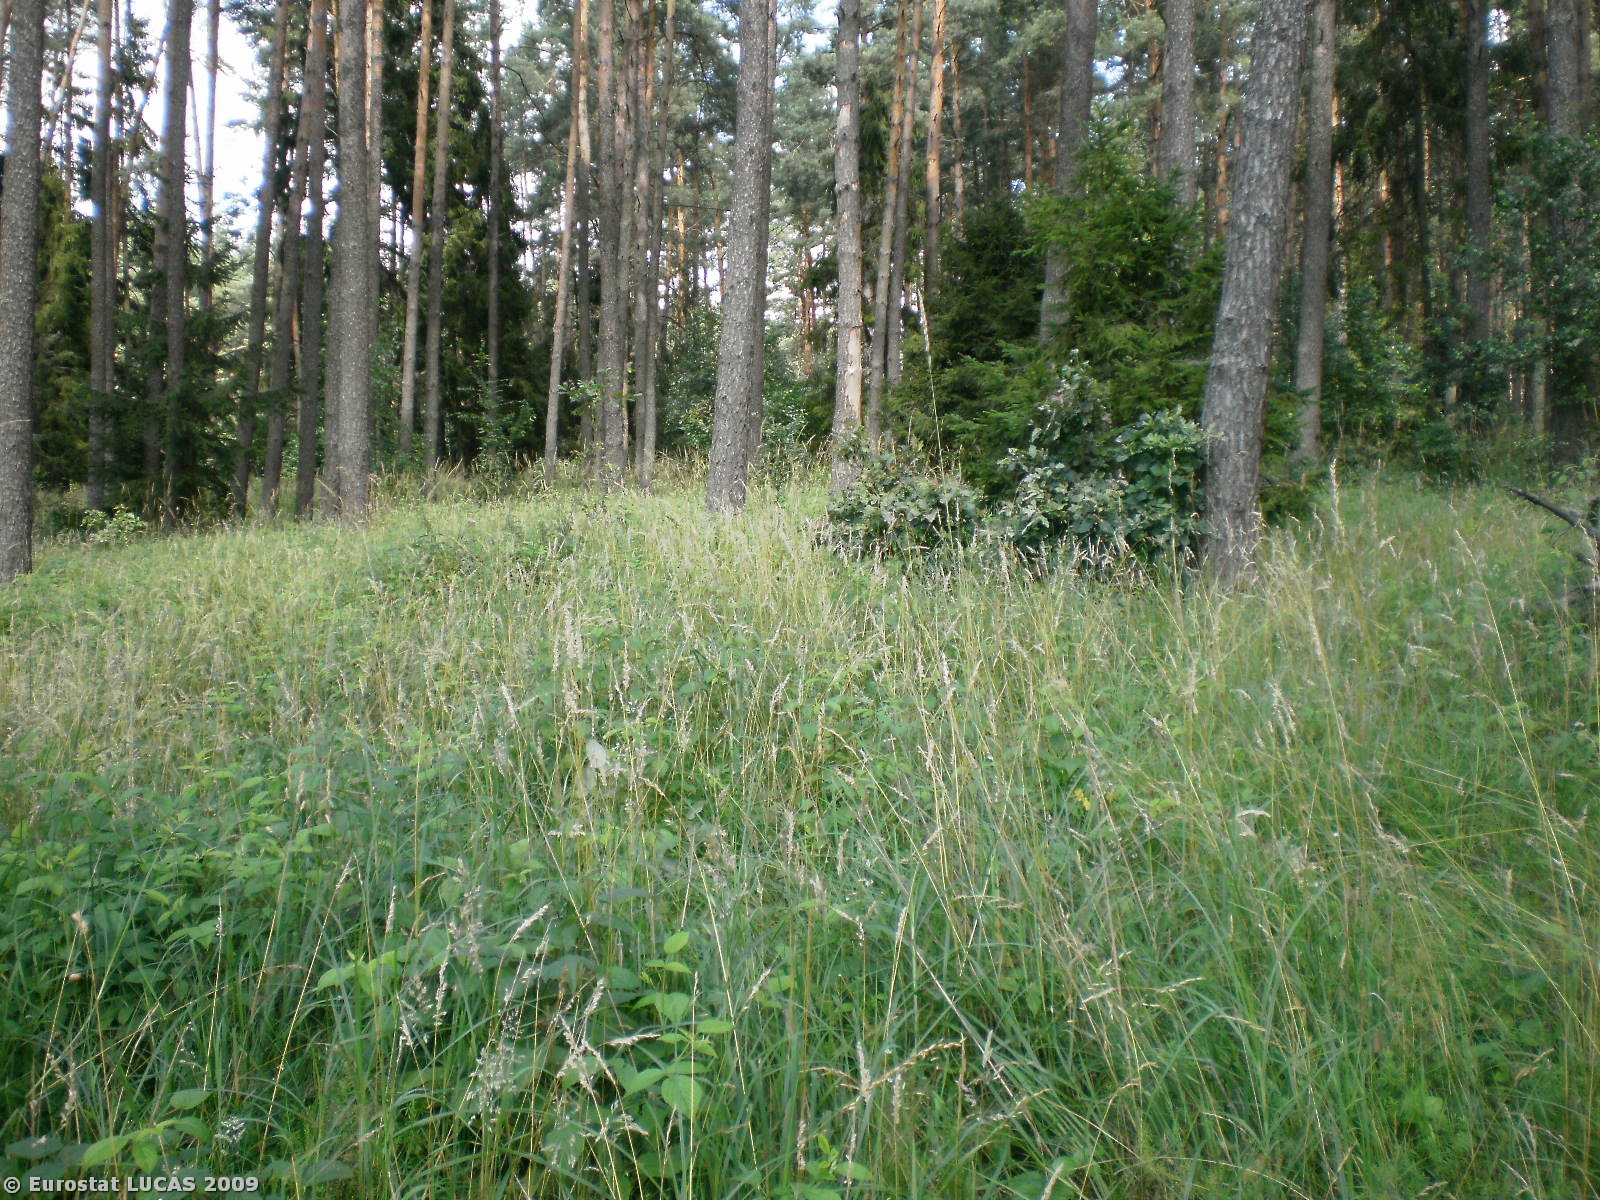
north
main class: Woodland
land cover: Coniferous woodland
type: hemiboreal forest and nemoral coniferous forest and mixed broadleaved-coniferous forest
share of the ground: 25 - 50 %
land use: Forestry
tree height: > 5 m
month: July
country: PL
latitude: 53.4543
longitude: 20.4730
